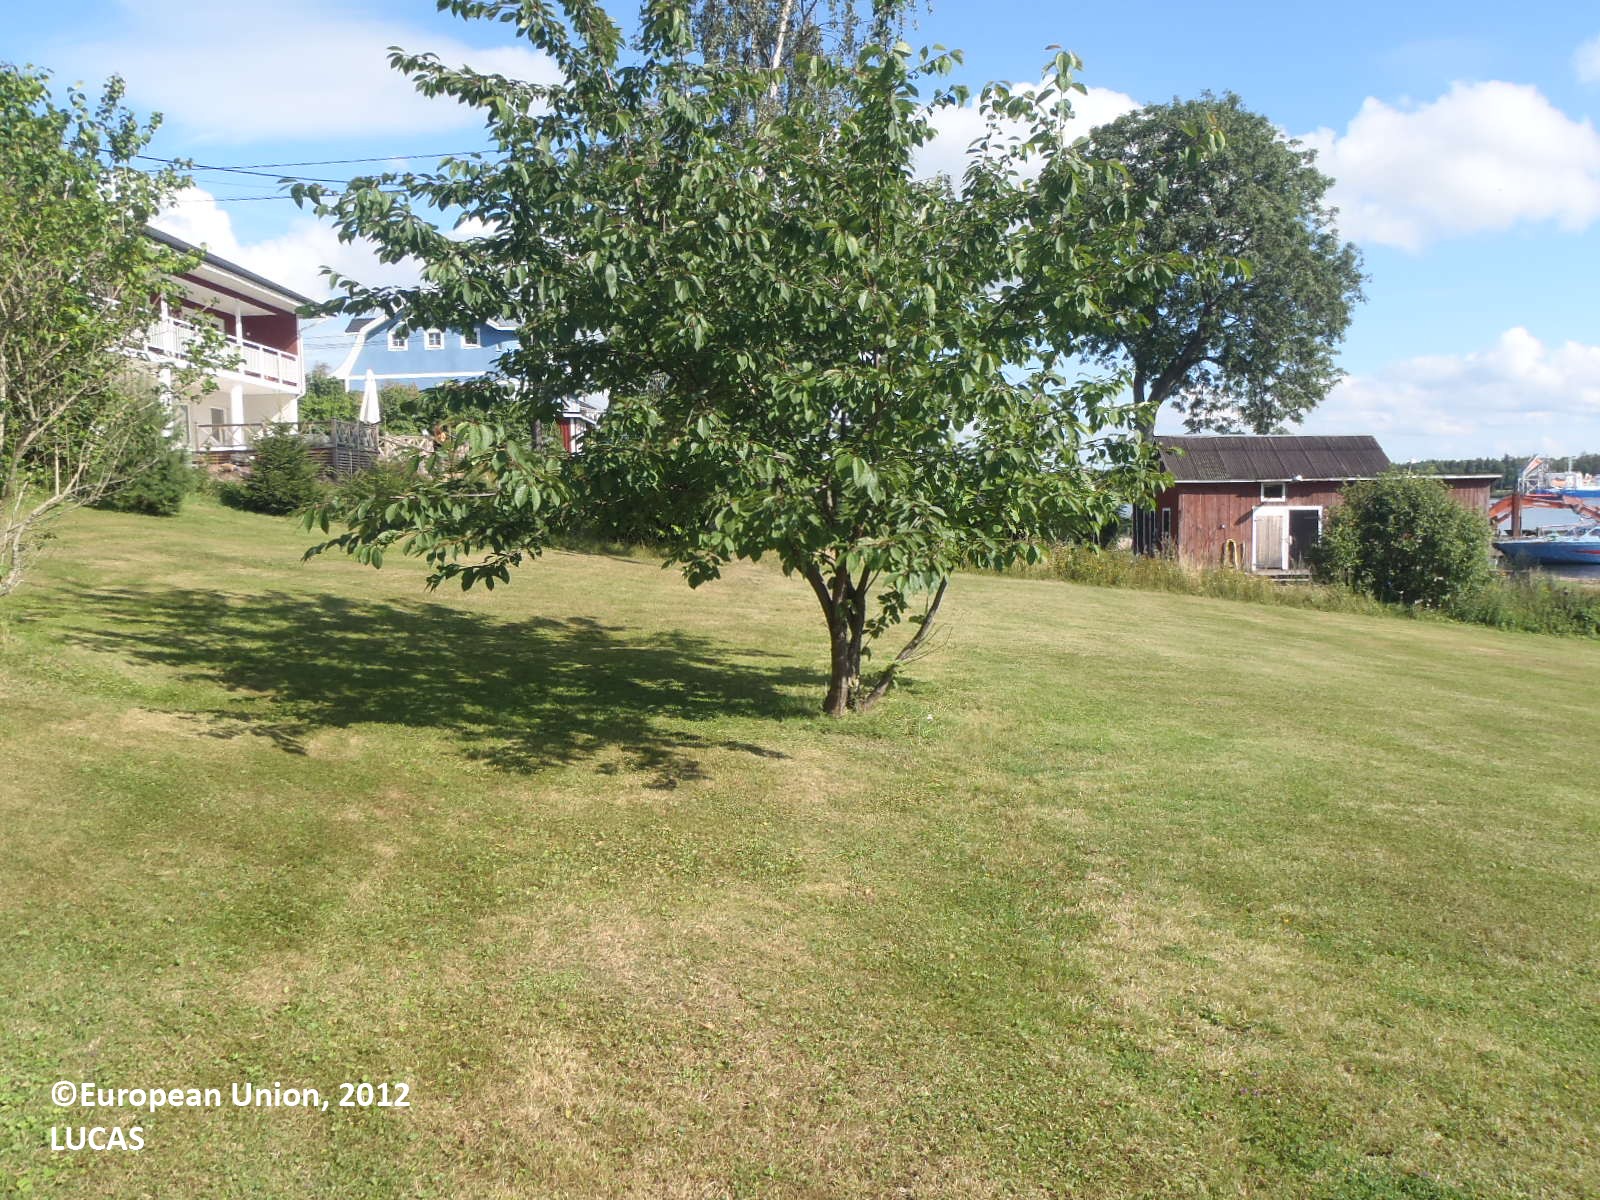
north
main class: Grassland
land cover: Grassland without tree/shrub cover
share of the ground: > 75 %
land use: Residential
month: August
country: FI
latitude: 60.1030
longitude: 19.9170
